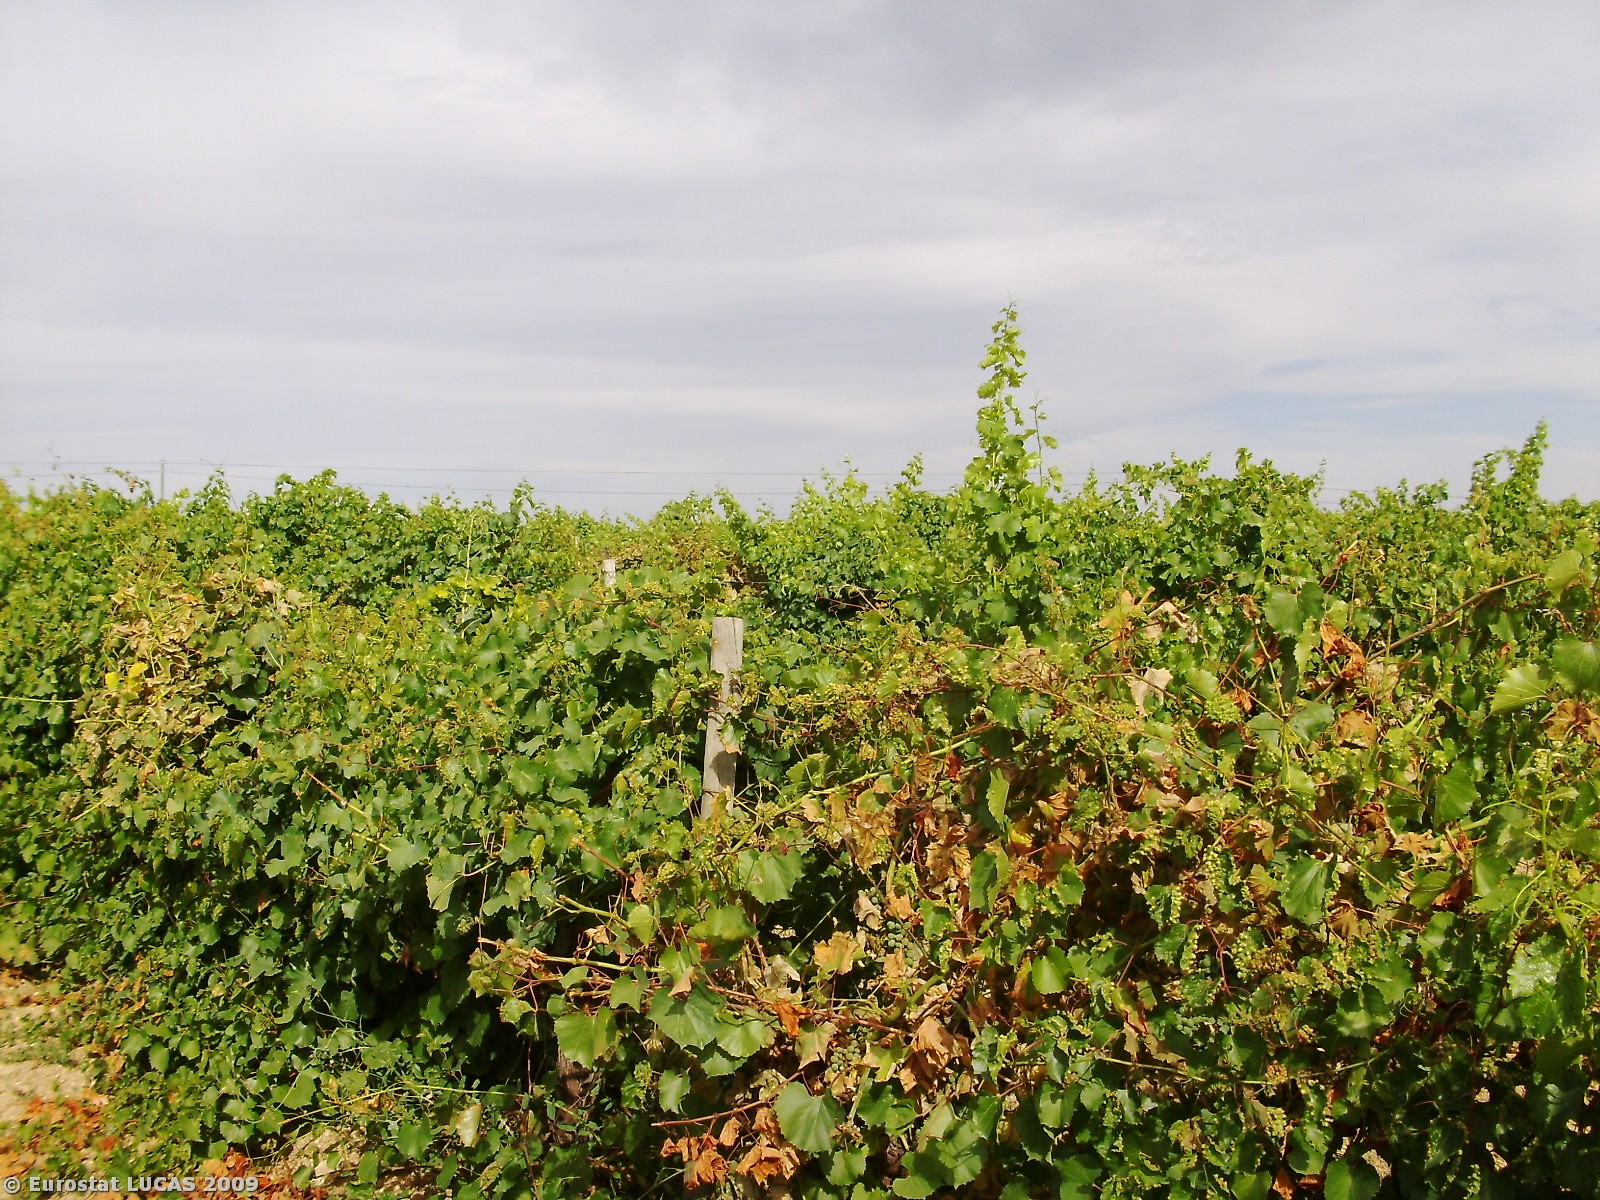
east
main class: Cropland
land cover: Vineyards
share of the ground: 25 - 50 %
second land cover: Bare land
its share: 50 - 75 %
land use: Agriculture (excluding fallow land and kitchen gardens)
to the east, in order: Vineyards; Bare land; Vineyards; Tracks; Vineyards; Electric lines; Vineyards; Bare land; Tracks; Fences; Paved roads, cycling and walking lanes; Tracks; Spontaneously vegetated surfaces
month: July
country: PT
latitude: 39.2965
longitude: -8.7318
